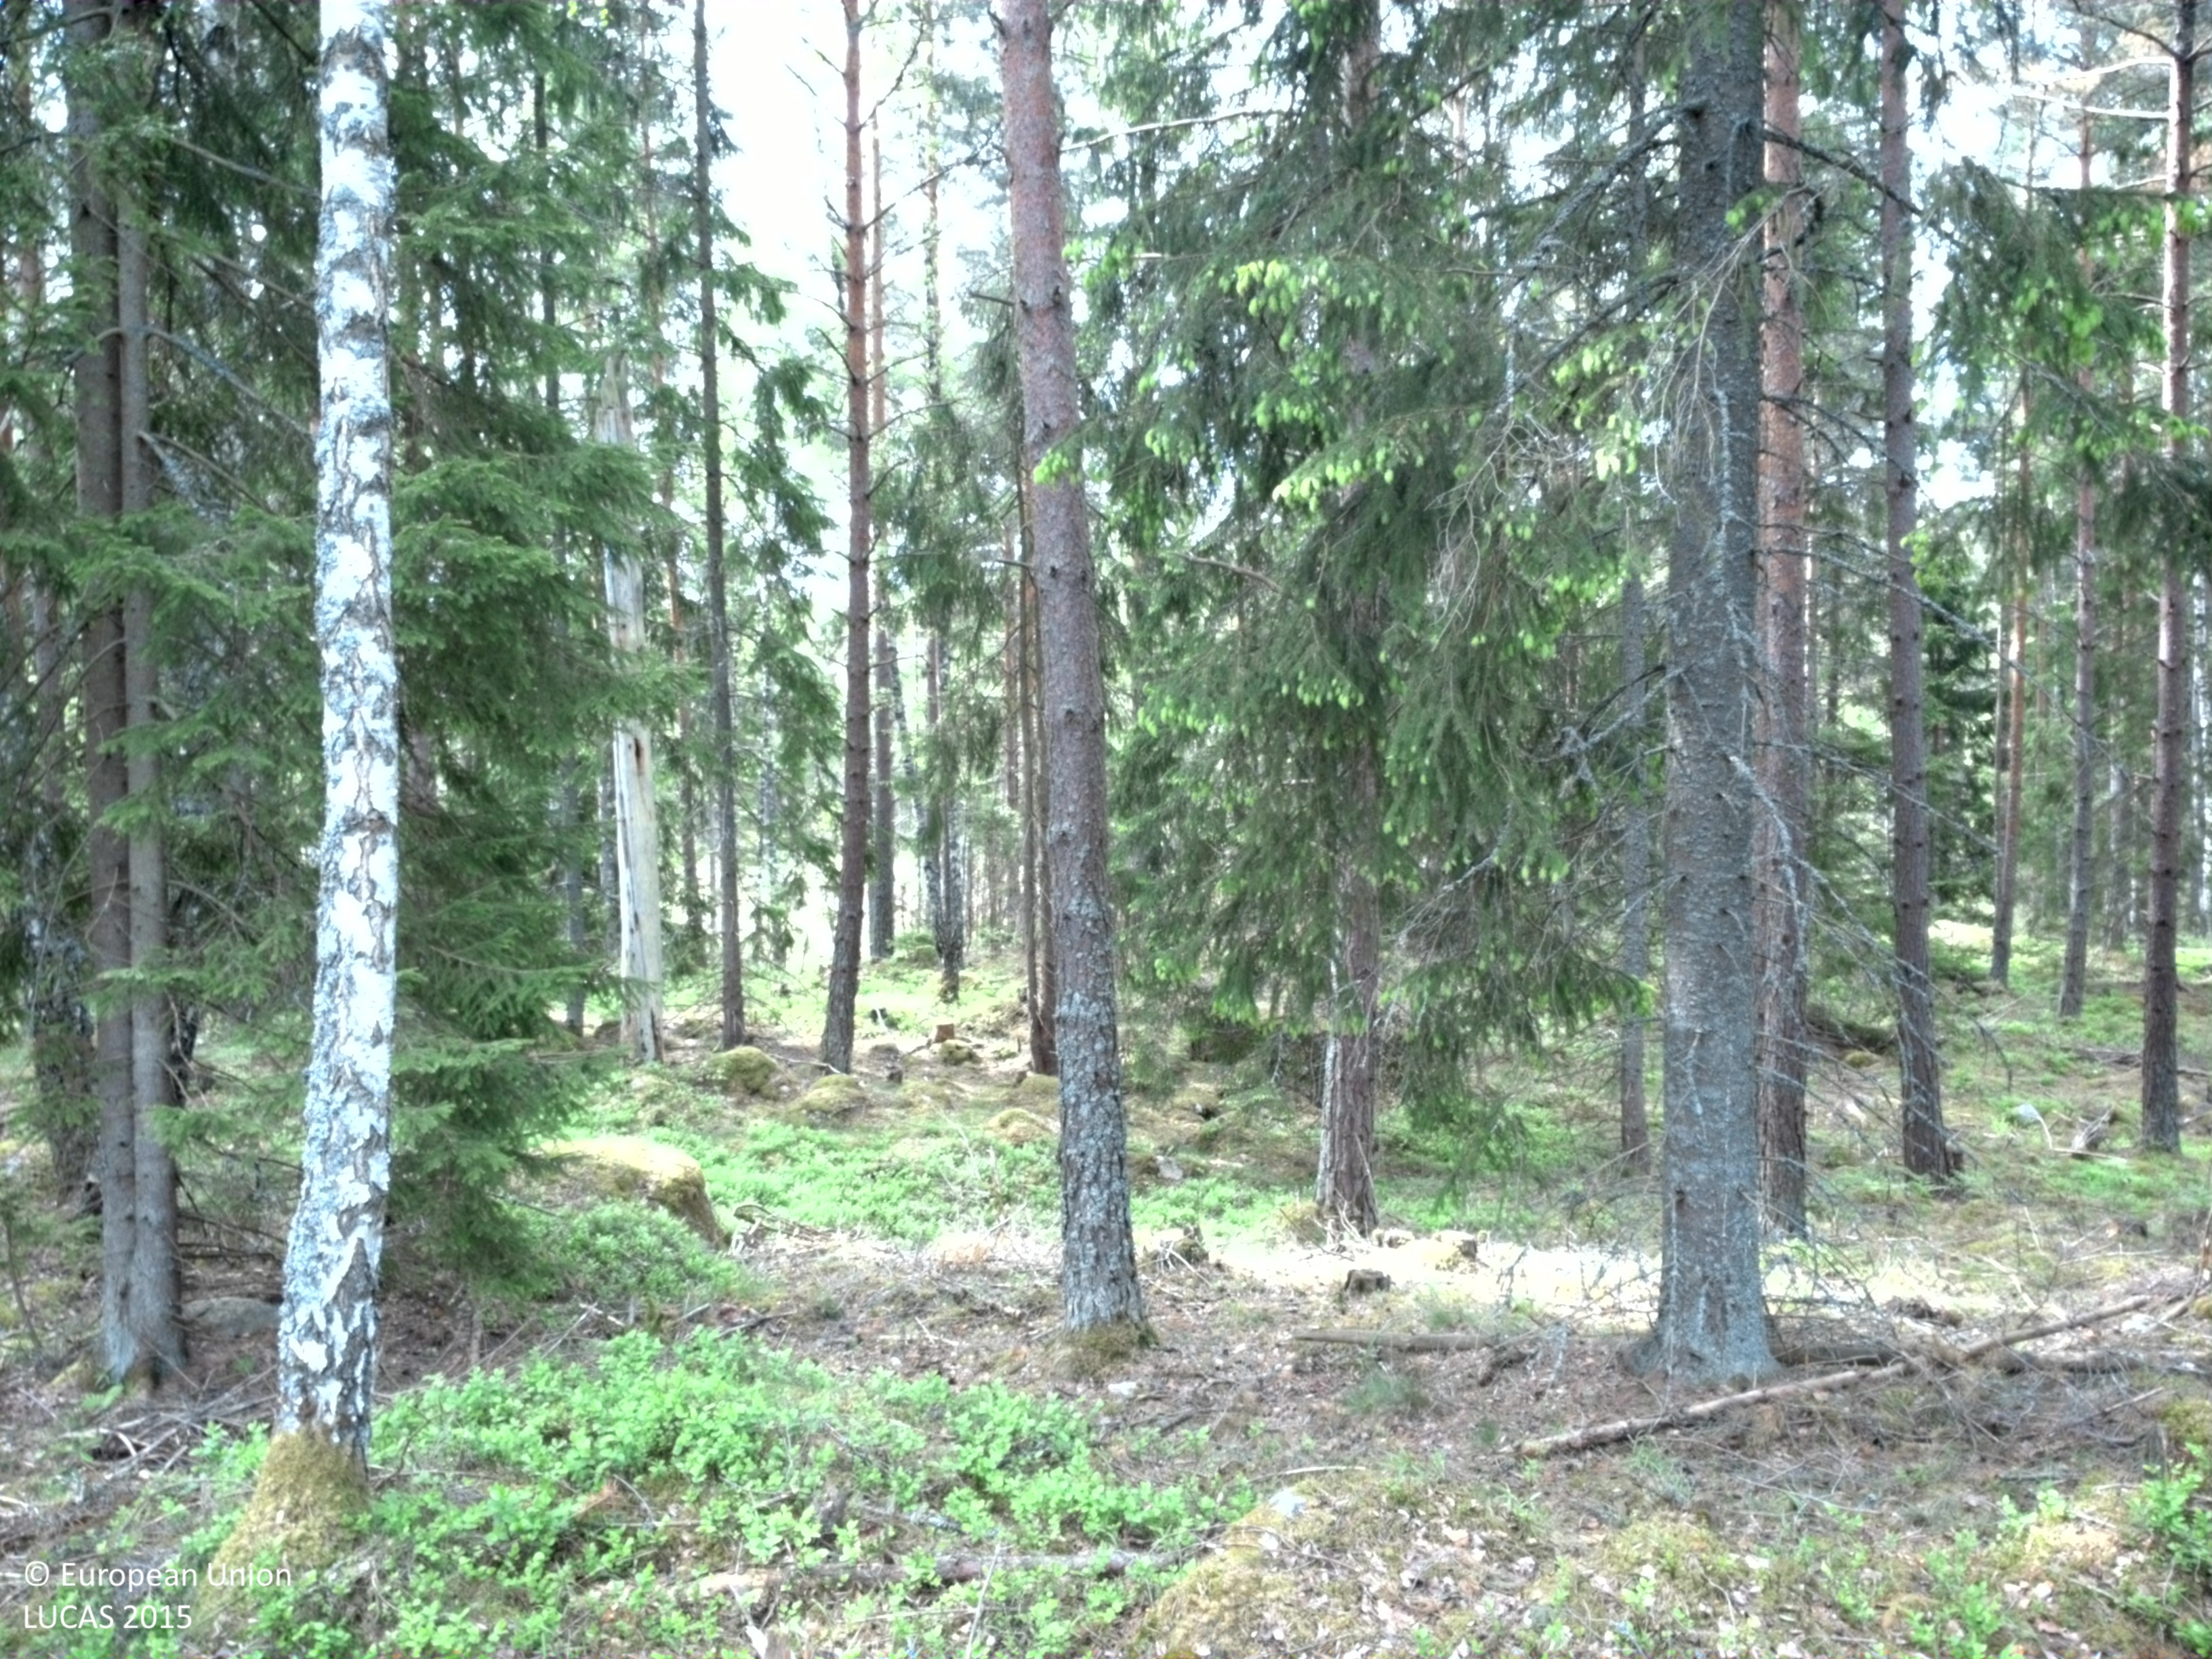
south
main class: Woodland
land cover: Pine dominated mixed woodland
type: boreal forest
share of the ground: 25 - 50 %
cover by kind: coniferous forest trees 25 %, broadleaved forest trees 25 %, shrubs 25 %, lichens and mosses 20 %, herbaceous plants 5 %
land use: Forestry
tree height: > 5 m
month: May
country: SE
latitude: 57.3456
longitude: 15.5973
